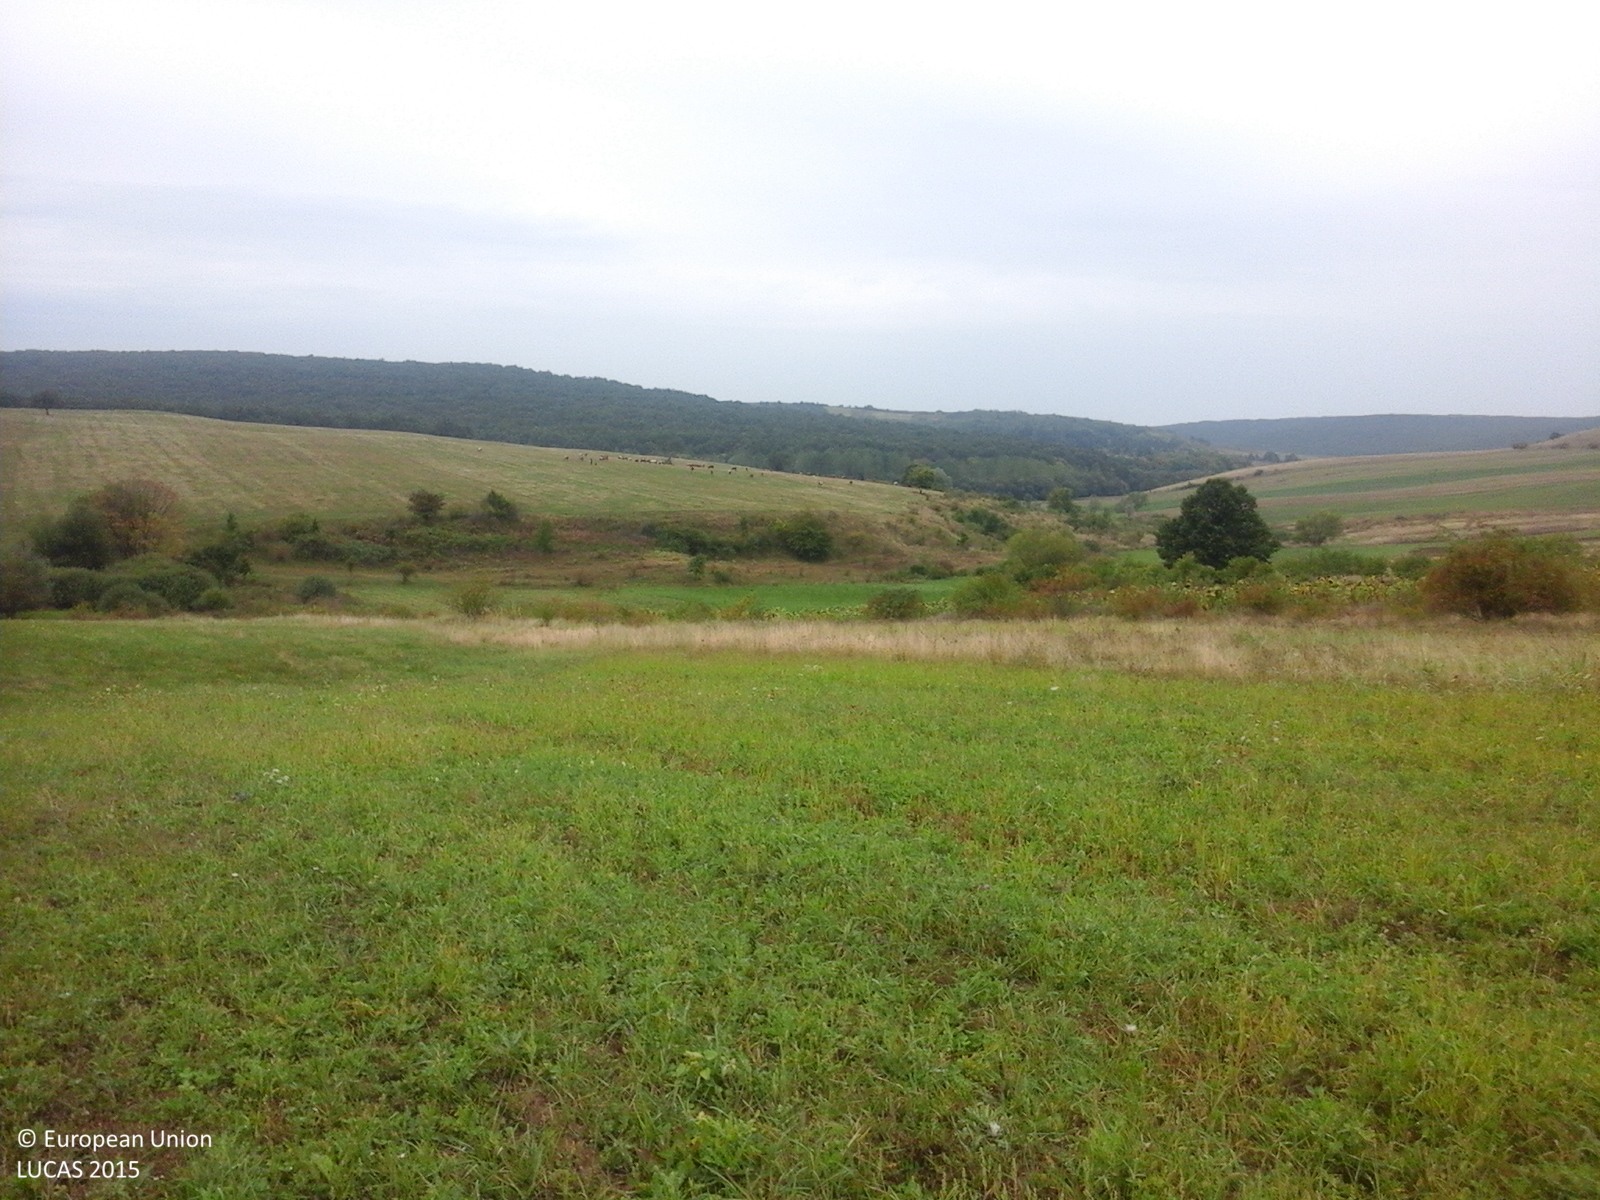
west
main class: Grassland
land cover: Grassland without tree/shrub cover
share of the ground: > 75 %
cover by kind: herbaceous plants 100 %
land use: Agriculture (excluding fallow land and kitchen gardens)
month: September
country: RO
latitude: 47.3906
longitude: 22.5768
